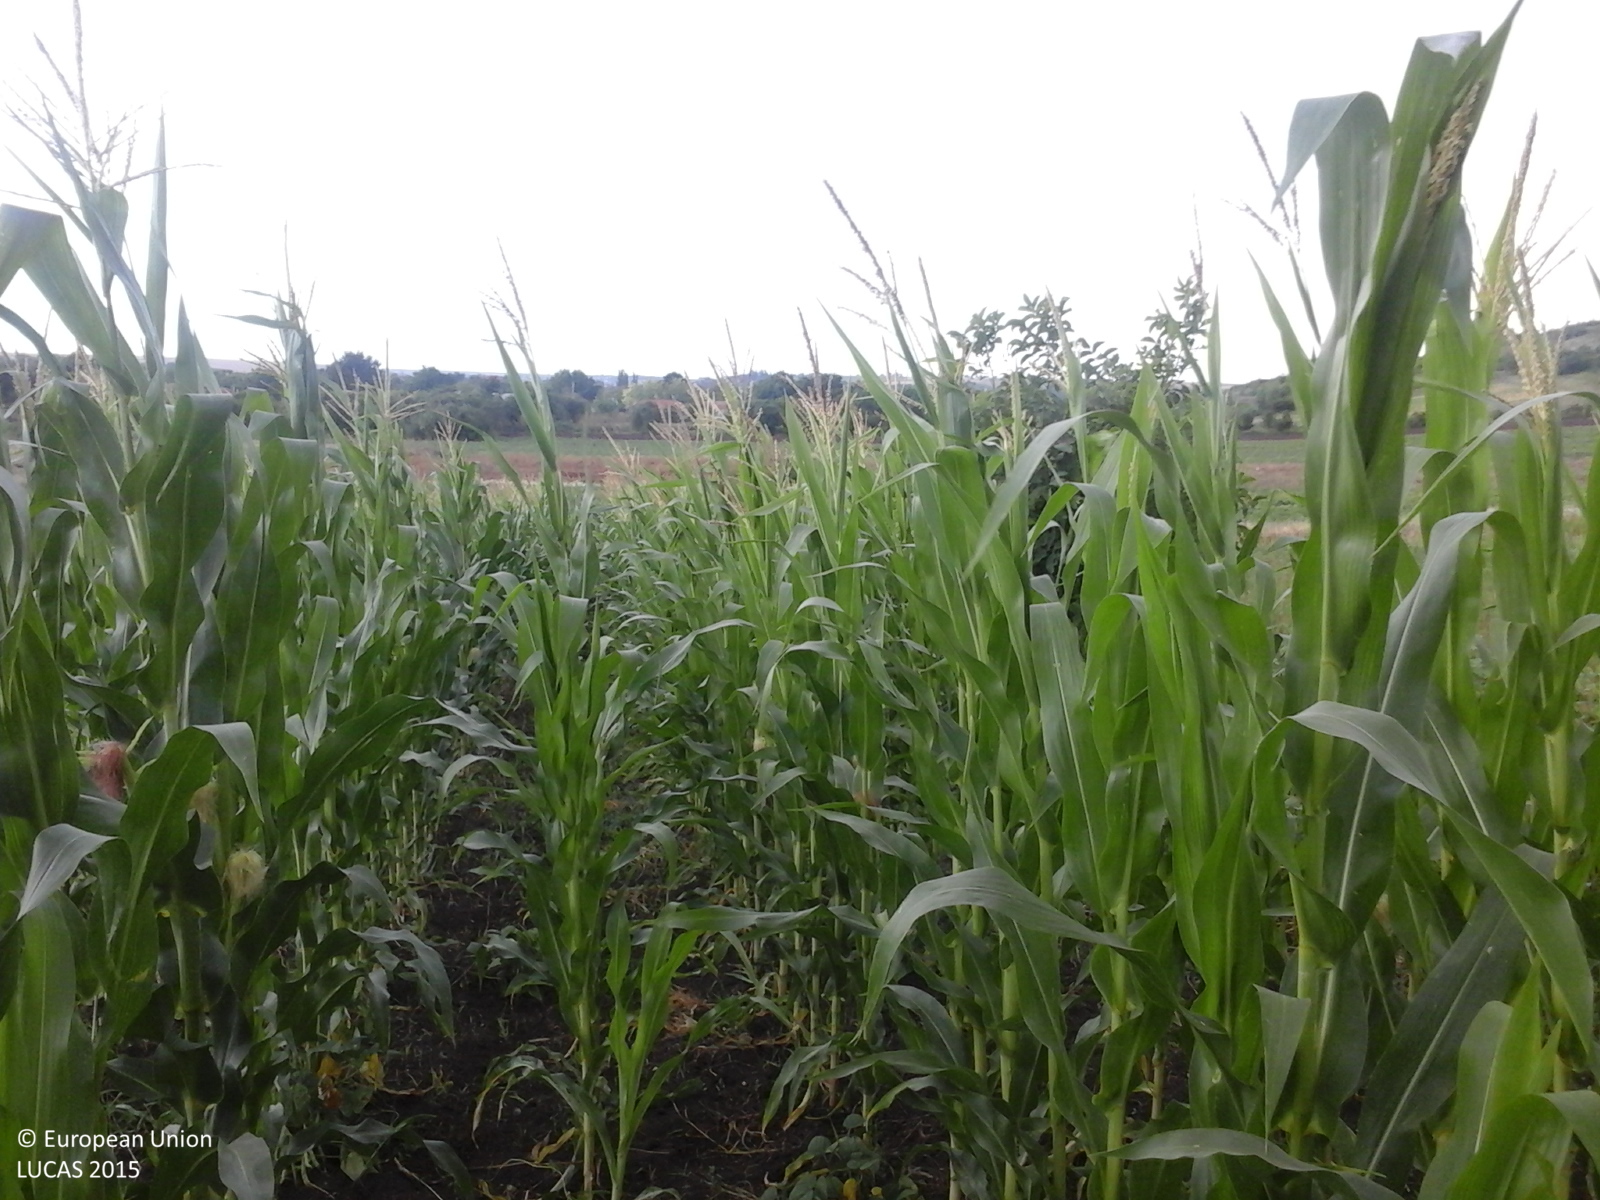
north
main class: Cropland
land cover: Maize
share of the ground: > 75 %
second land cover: Dry pulses
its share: < 10 %
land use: Agriculture (excluding fallow land and kitchen gardens)
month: July
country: RO
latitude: 43.8546
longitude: 25.1432
